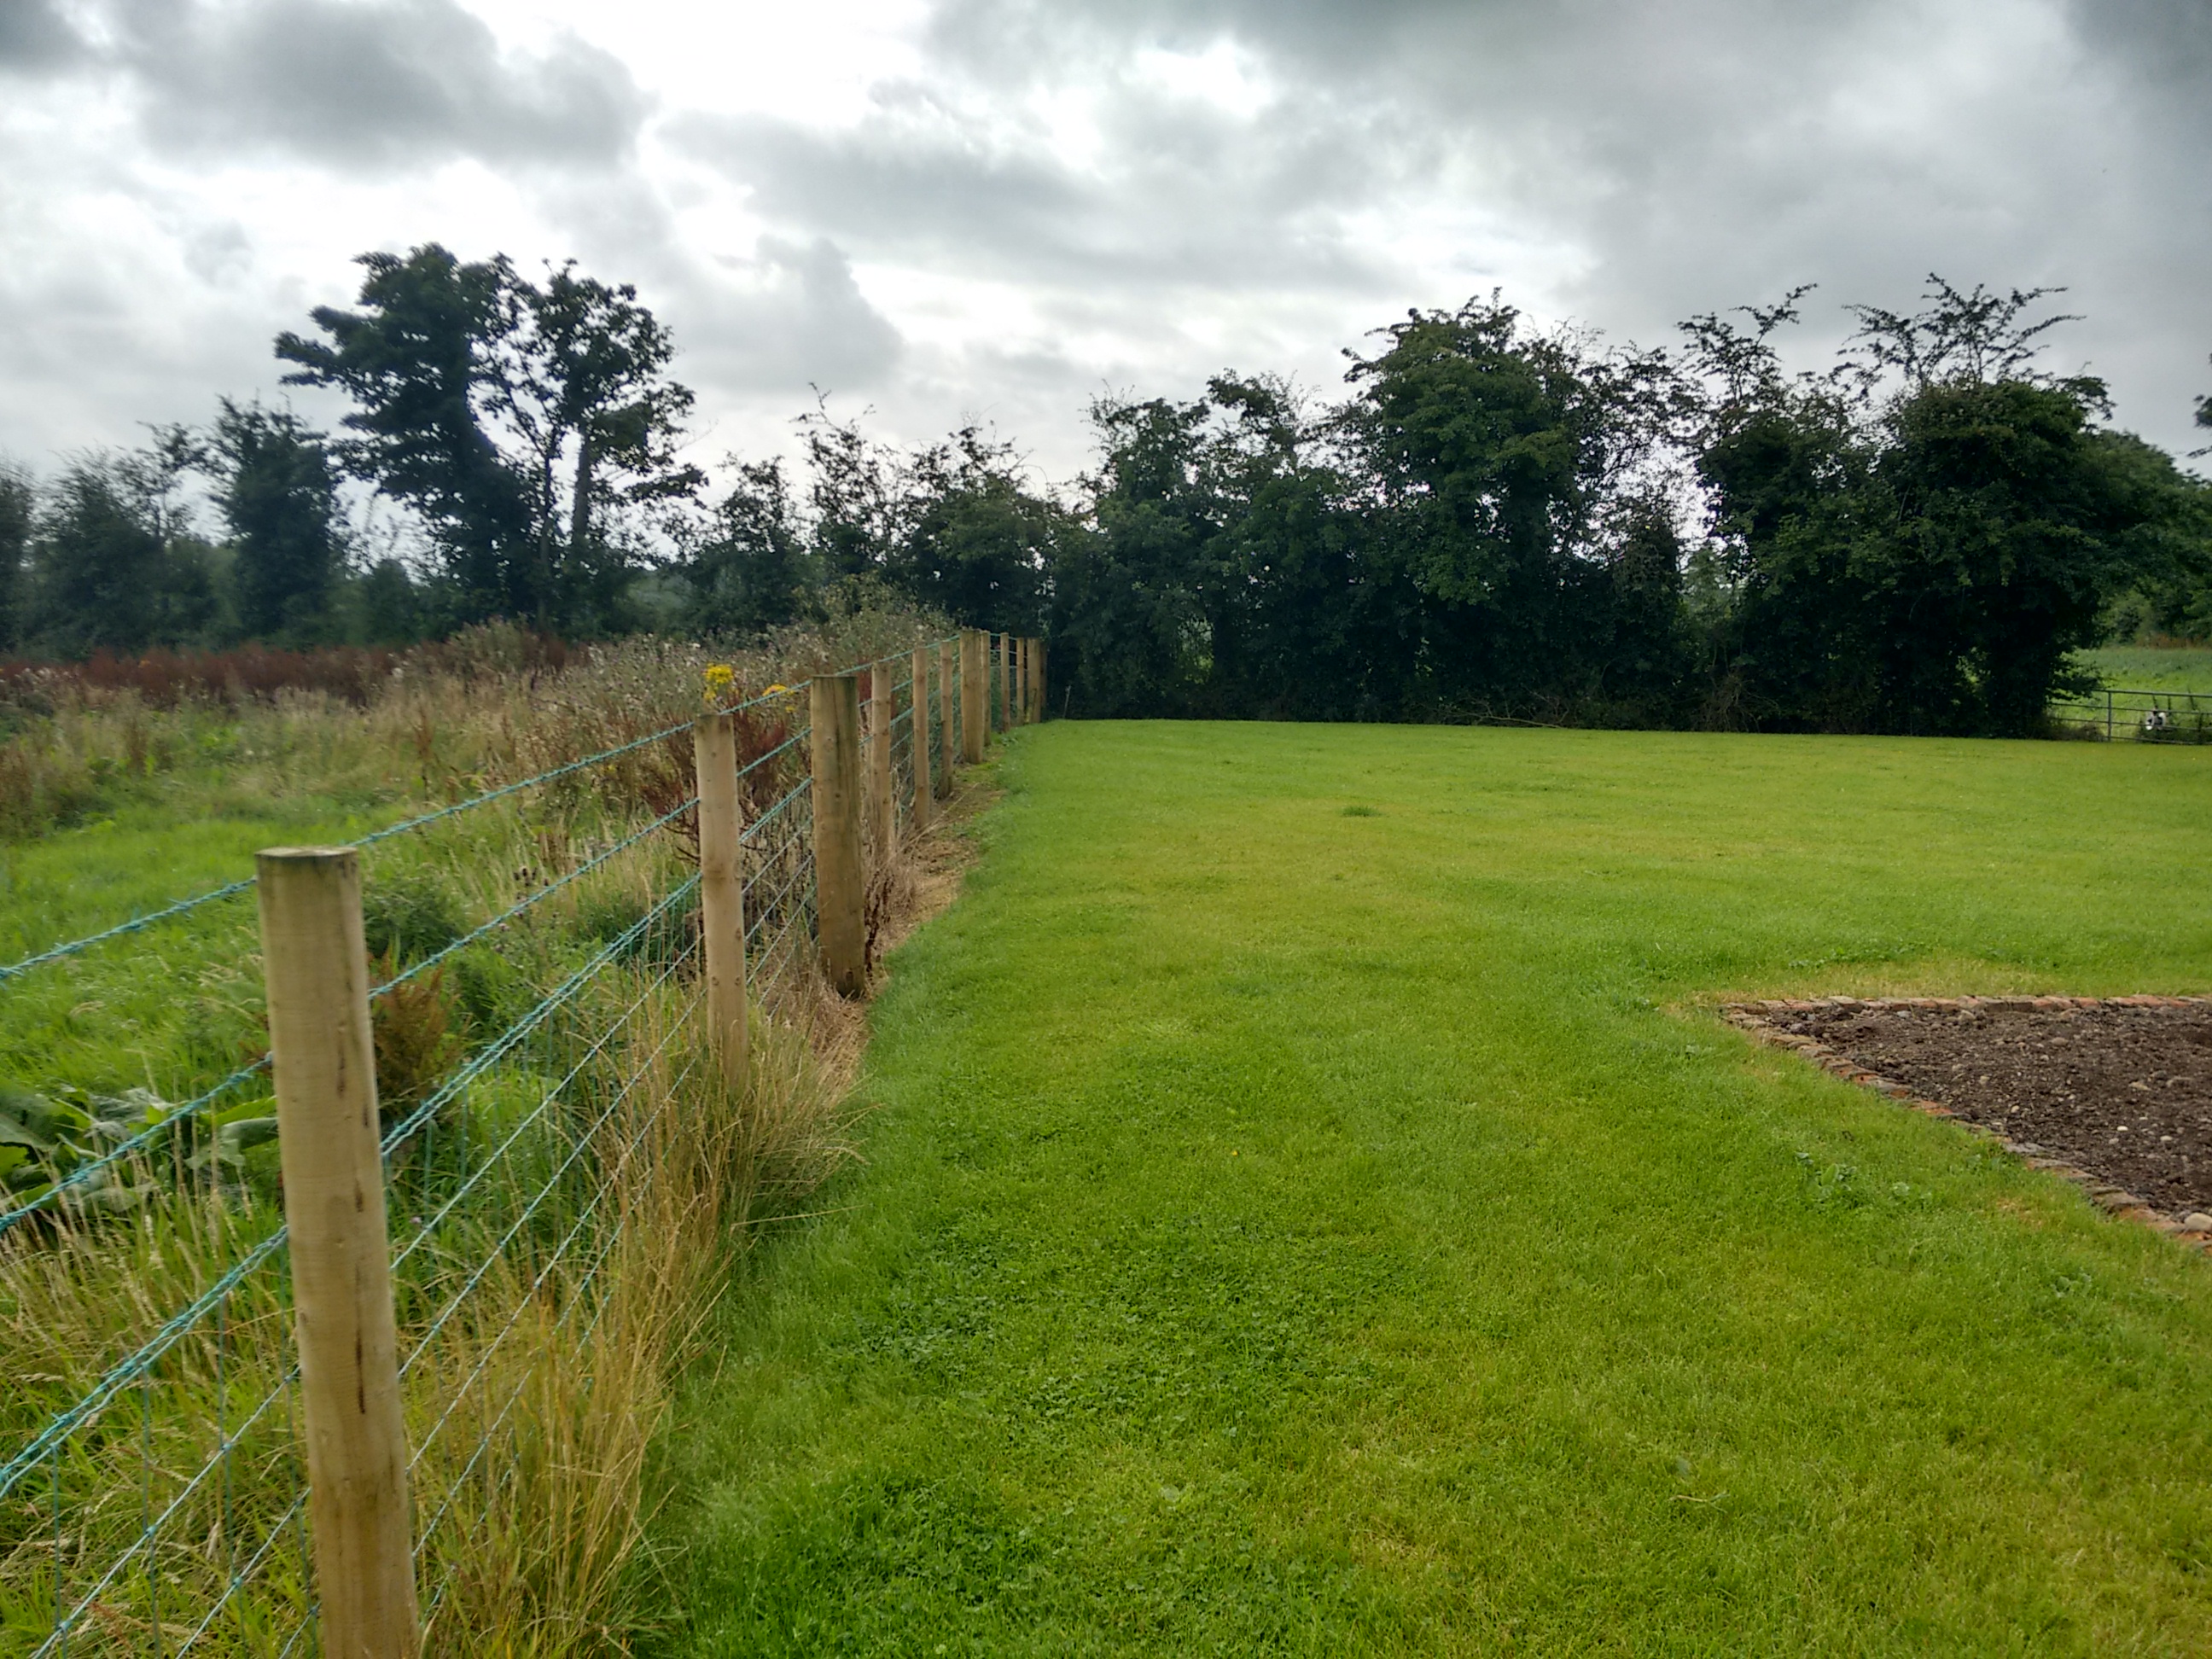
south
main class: Grassland
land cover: Grassland without tree/shrub cover
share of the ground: > 75 %
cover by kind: herbaceous plants 100 %
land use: Agriculture (excluding fallow land and kitchen gardens)
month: August
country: GB
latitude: 54.4109
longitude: -6.7574
